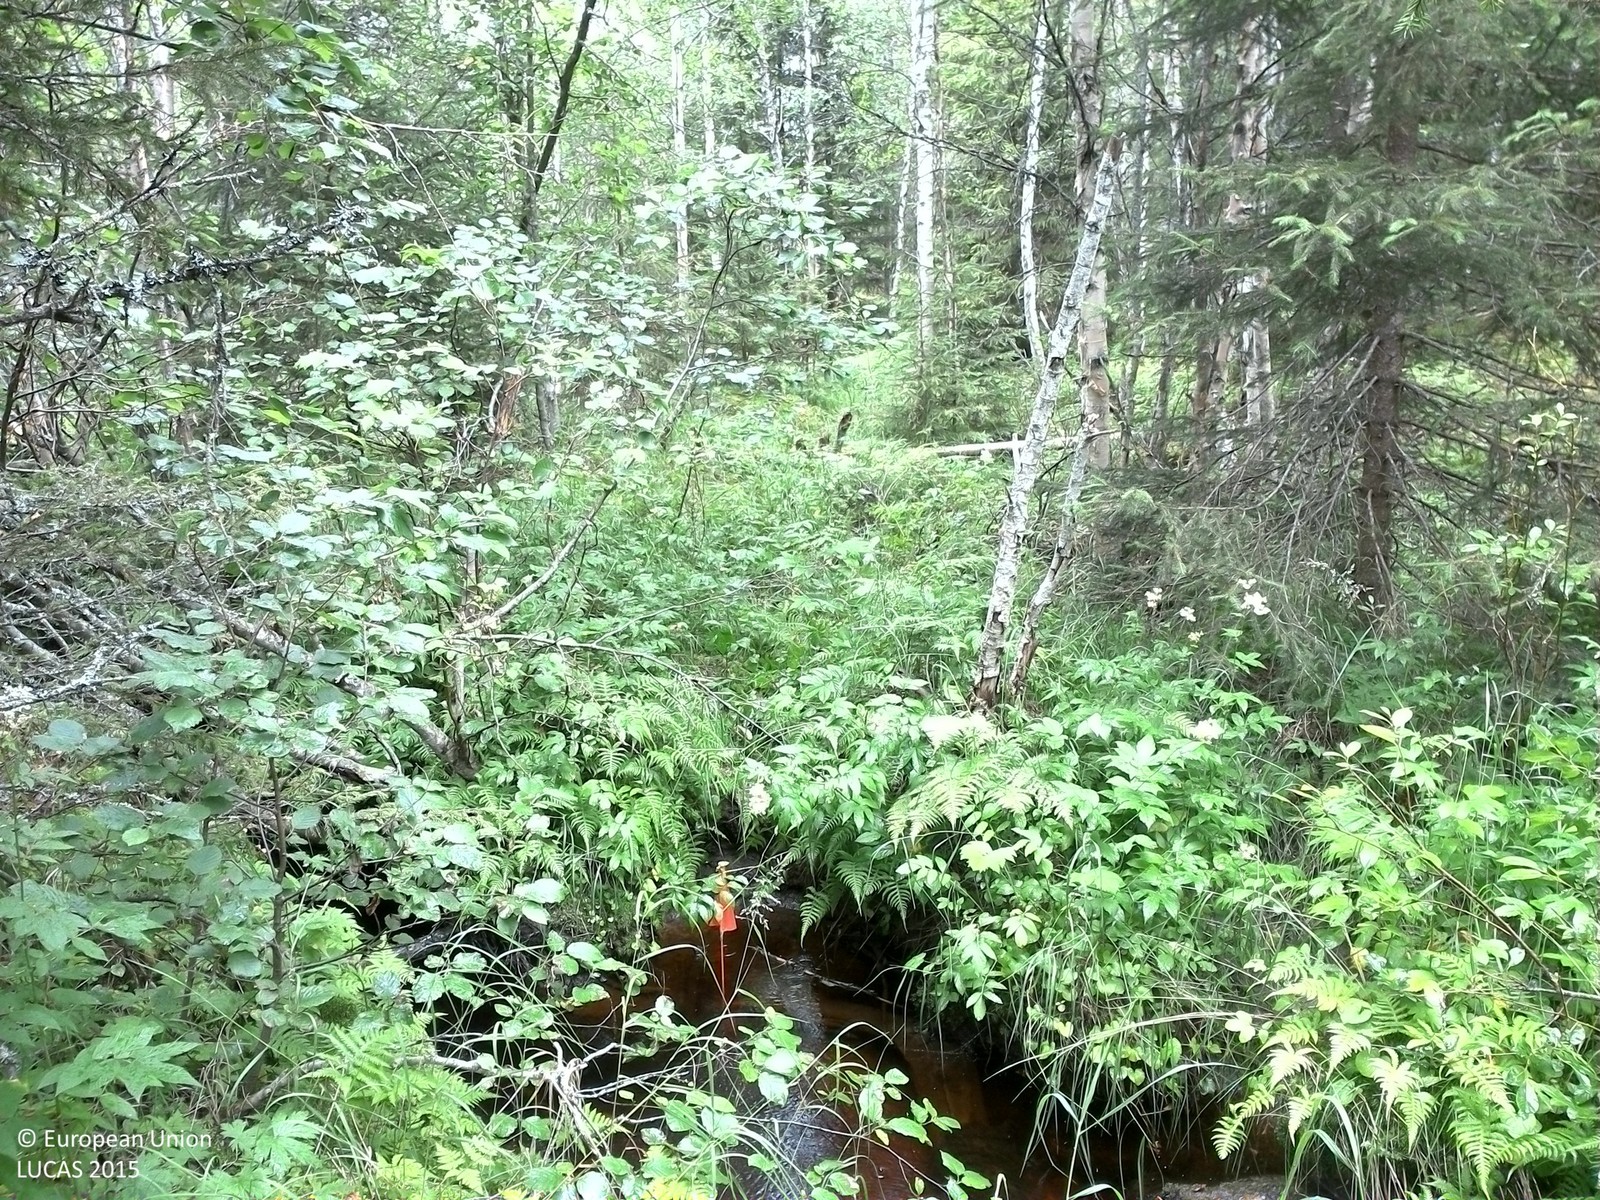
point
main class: Woodland
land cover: Spruce dominated mixed woodland
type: boreal forest
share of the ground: > 75 %
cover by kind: coniferous forest trees 45 %, broadleaved forest trees 40 %, herbaceous plants 15 %
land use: Forestry
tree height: > 5 m
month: August
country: SE
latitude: 63.6415
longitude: 18.1906
